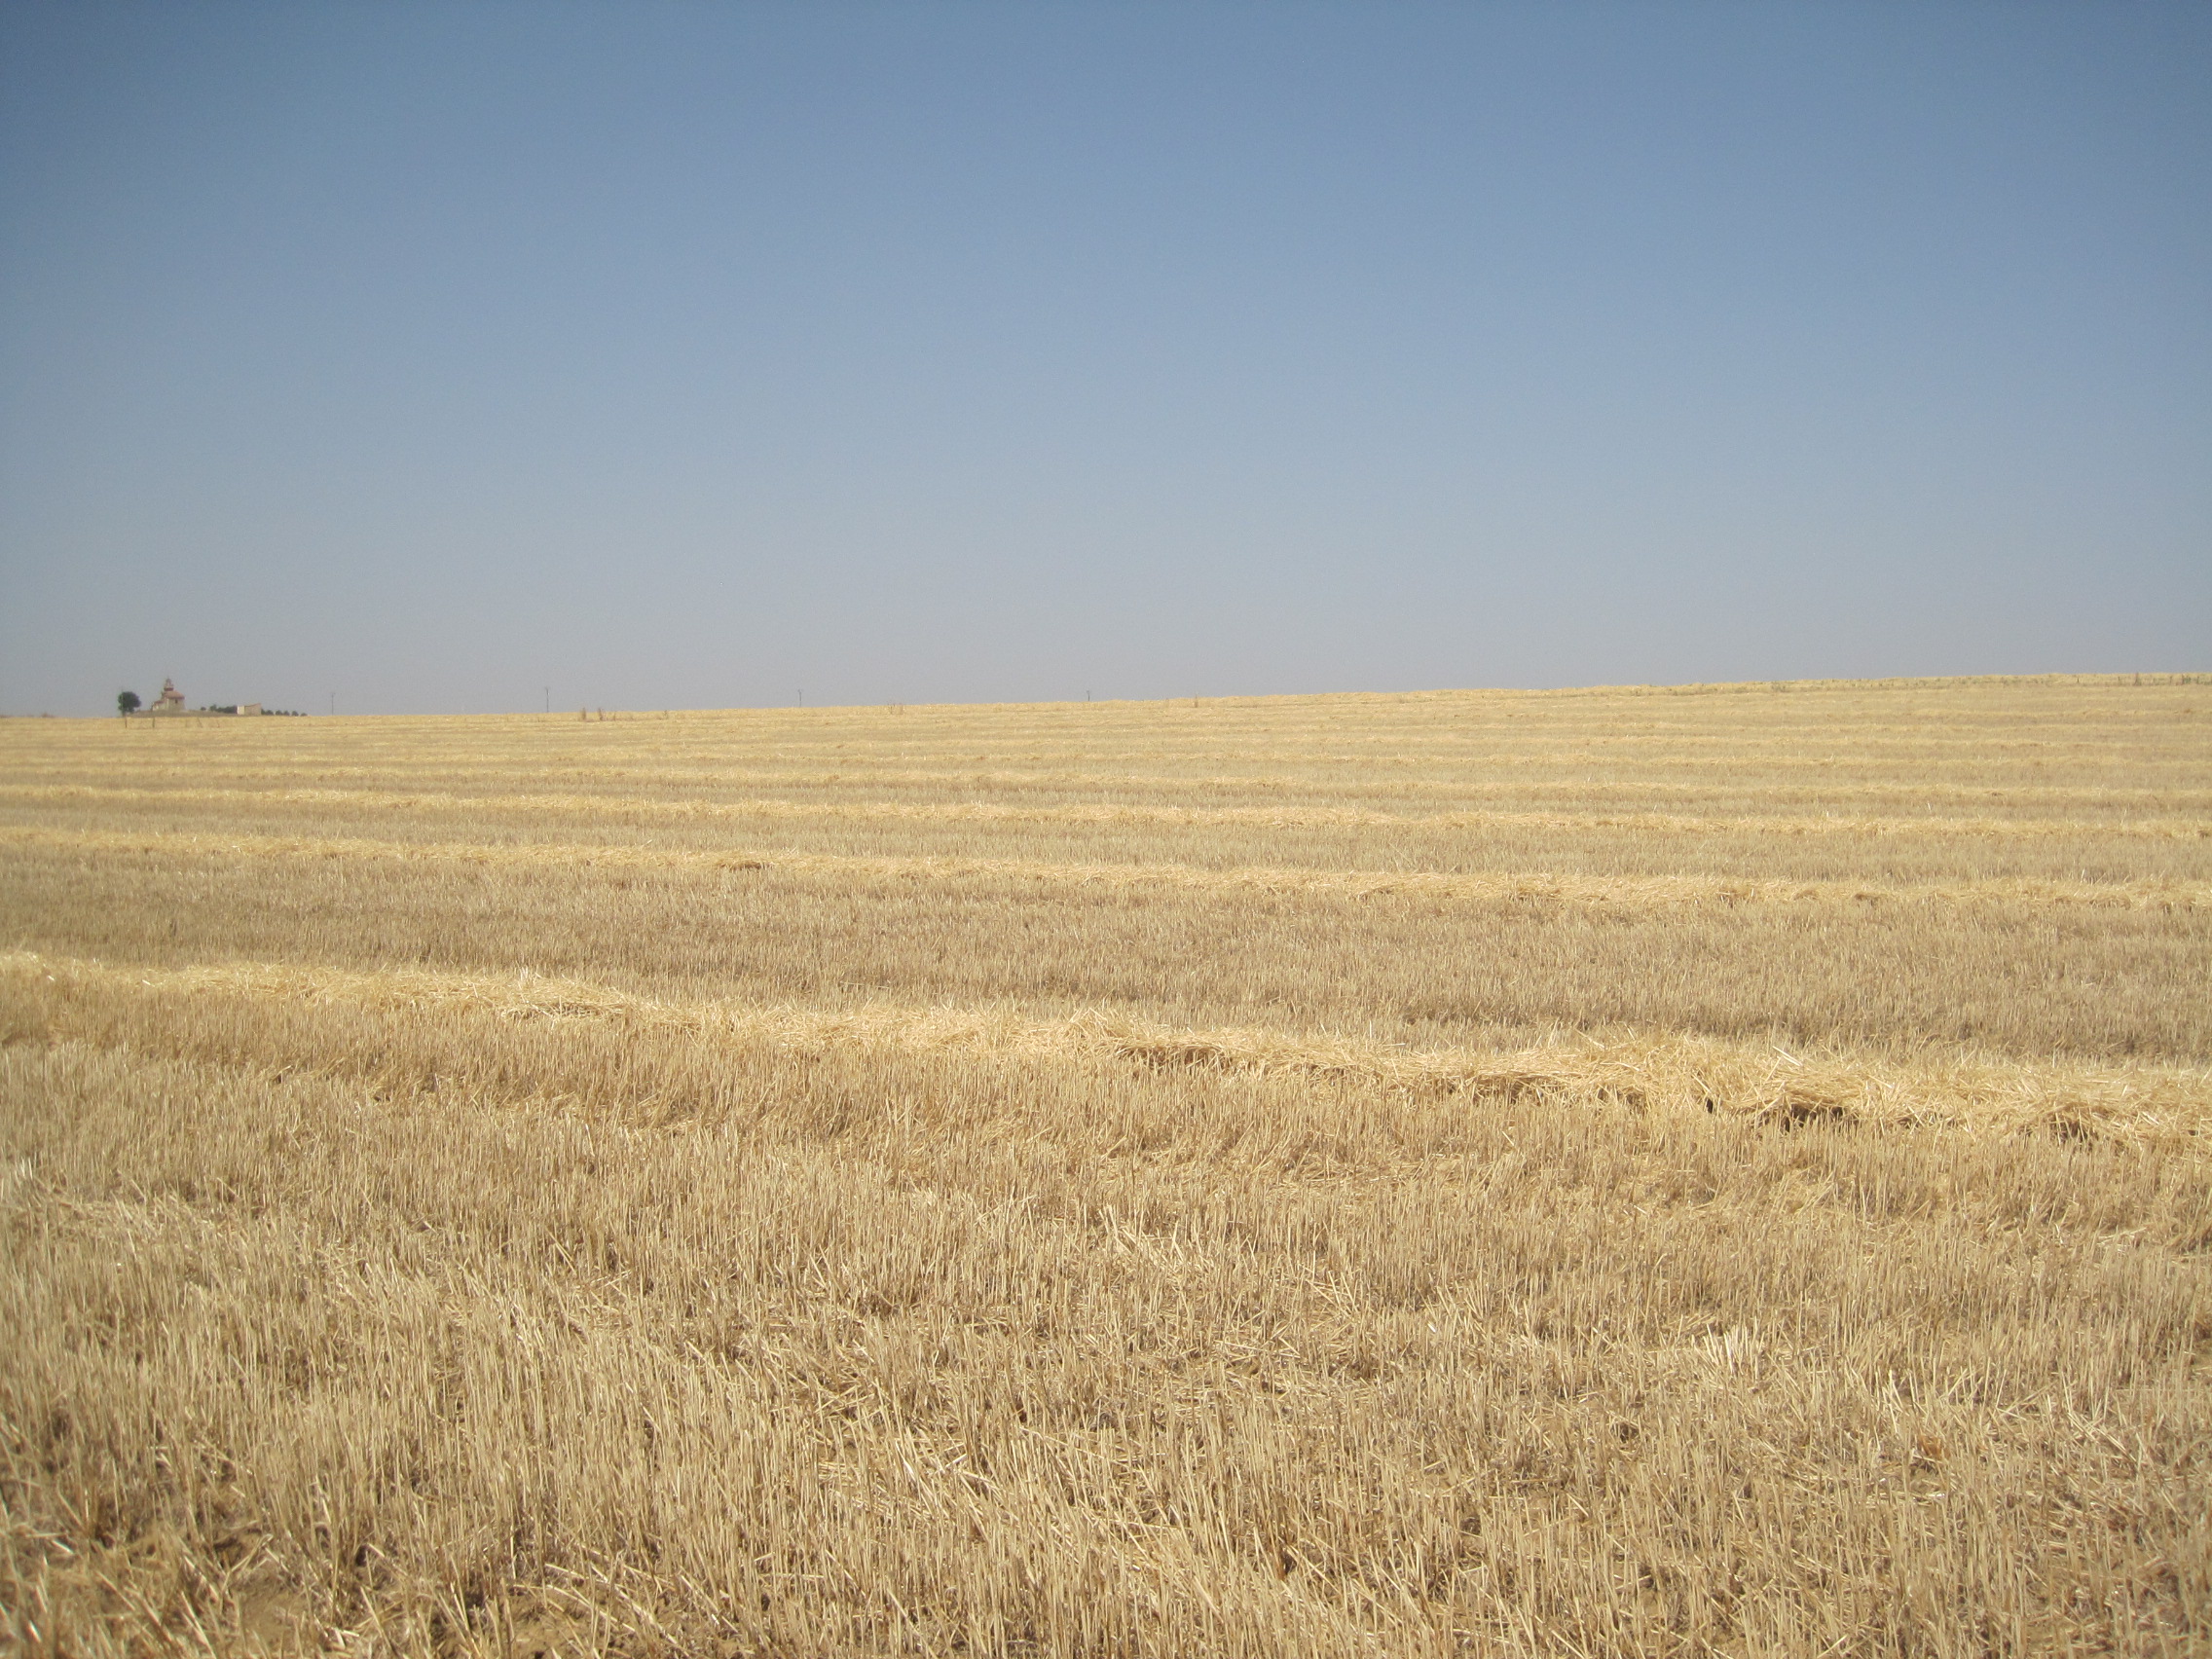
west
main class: Cropland
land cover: Barley
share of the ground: < 10 %
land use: Agriculture (excluding fallow land and kitchen gardens)
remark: Harvested field
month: July
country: ES
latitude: 41.6596
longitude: -5.4665
